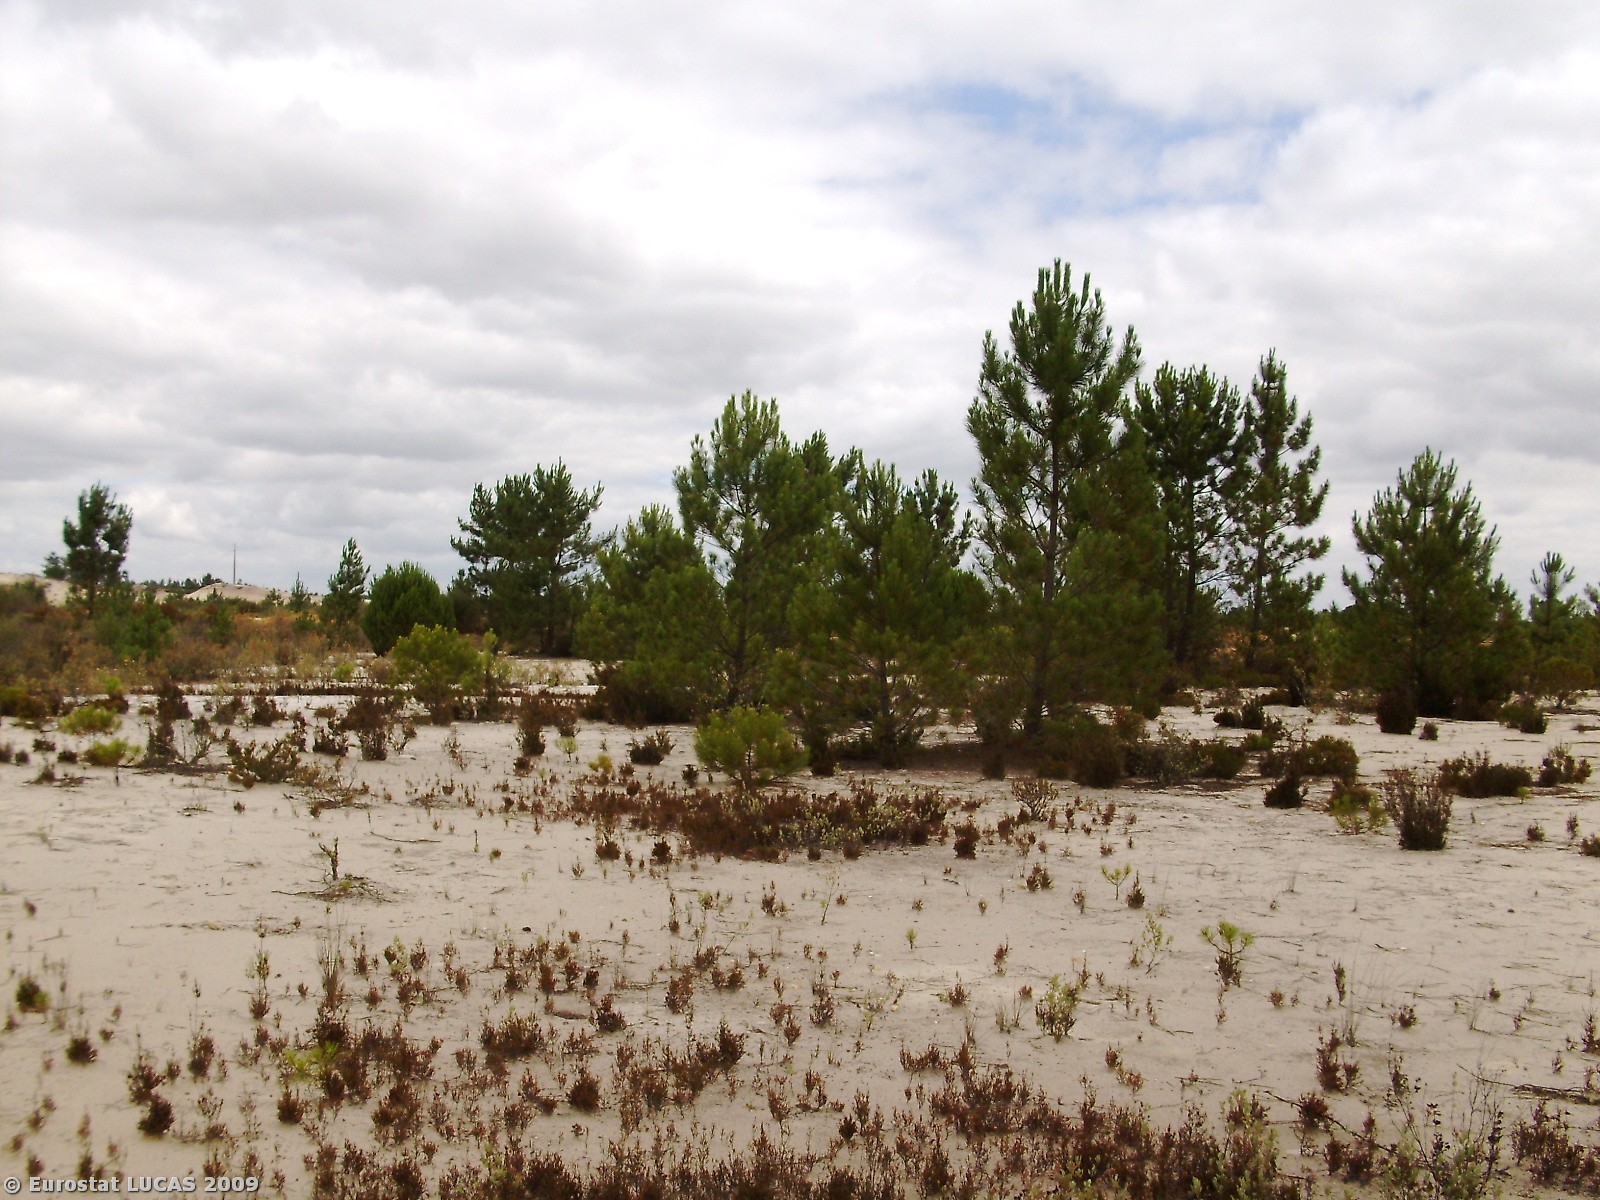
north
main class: Woodland
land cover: Coniferous woodland
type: coniferous forest of the mediterranean region
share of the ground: 25 - 50 %
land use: Forestry
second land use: Mining and quarrying
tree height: > 5 m
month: June
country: PT
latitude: 38.2625
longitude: -8.5296
